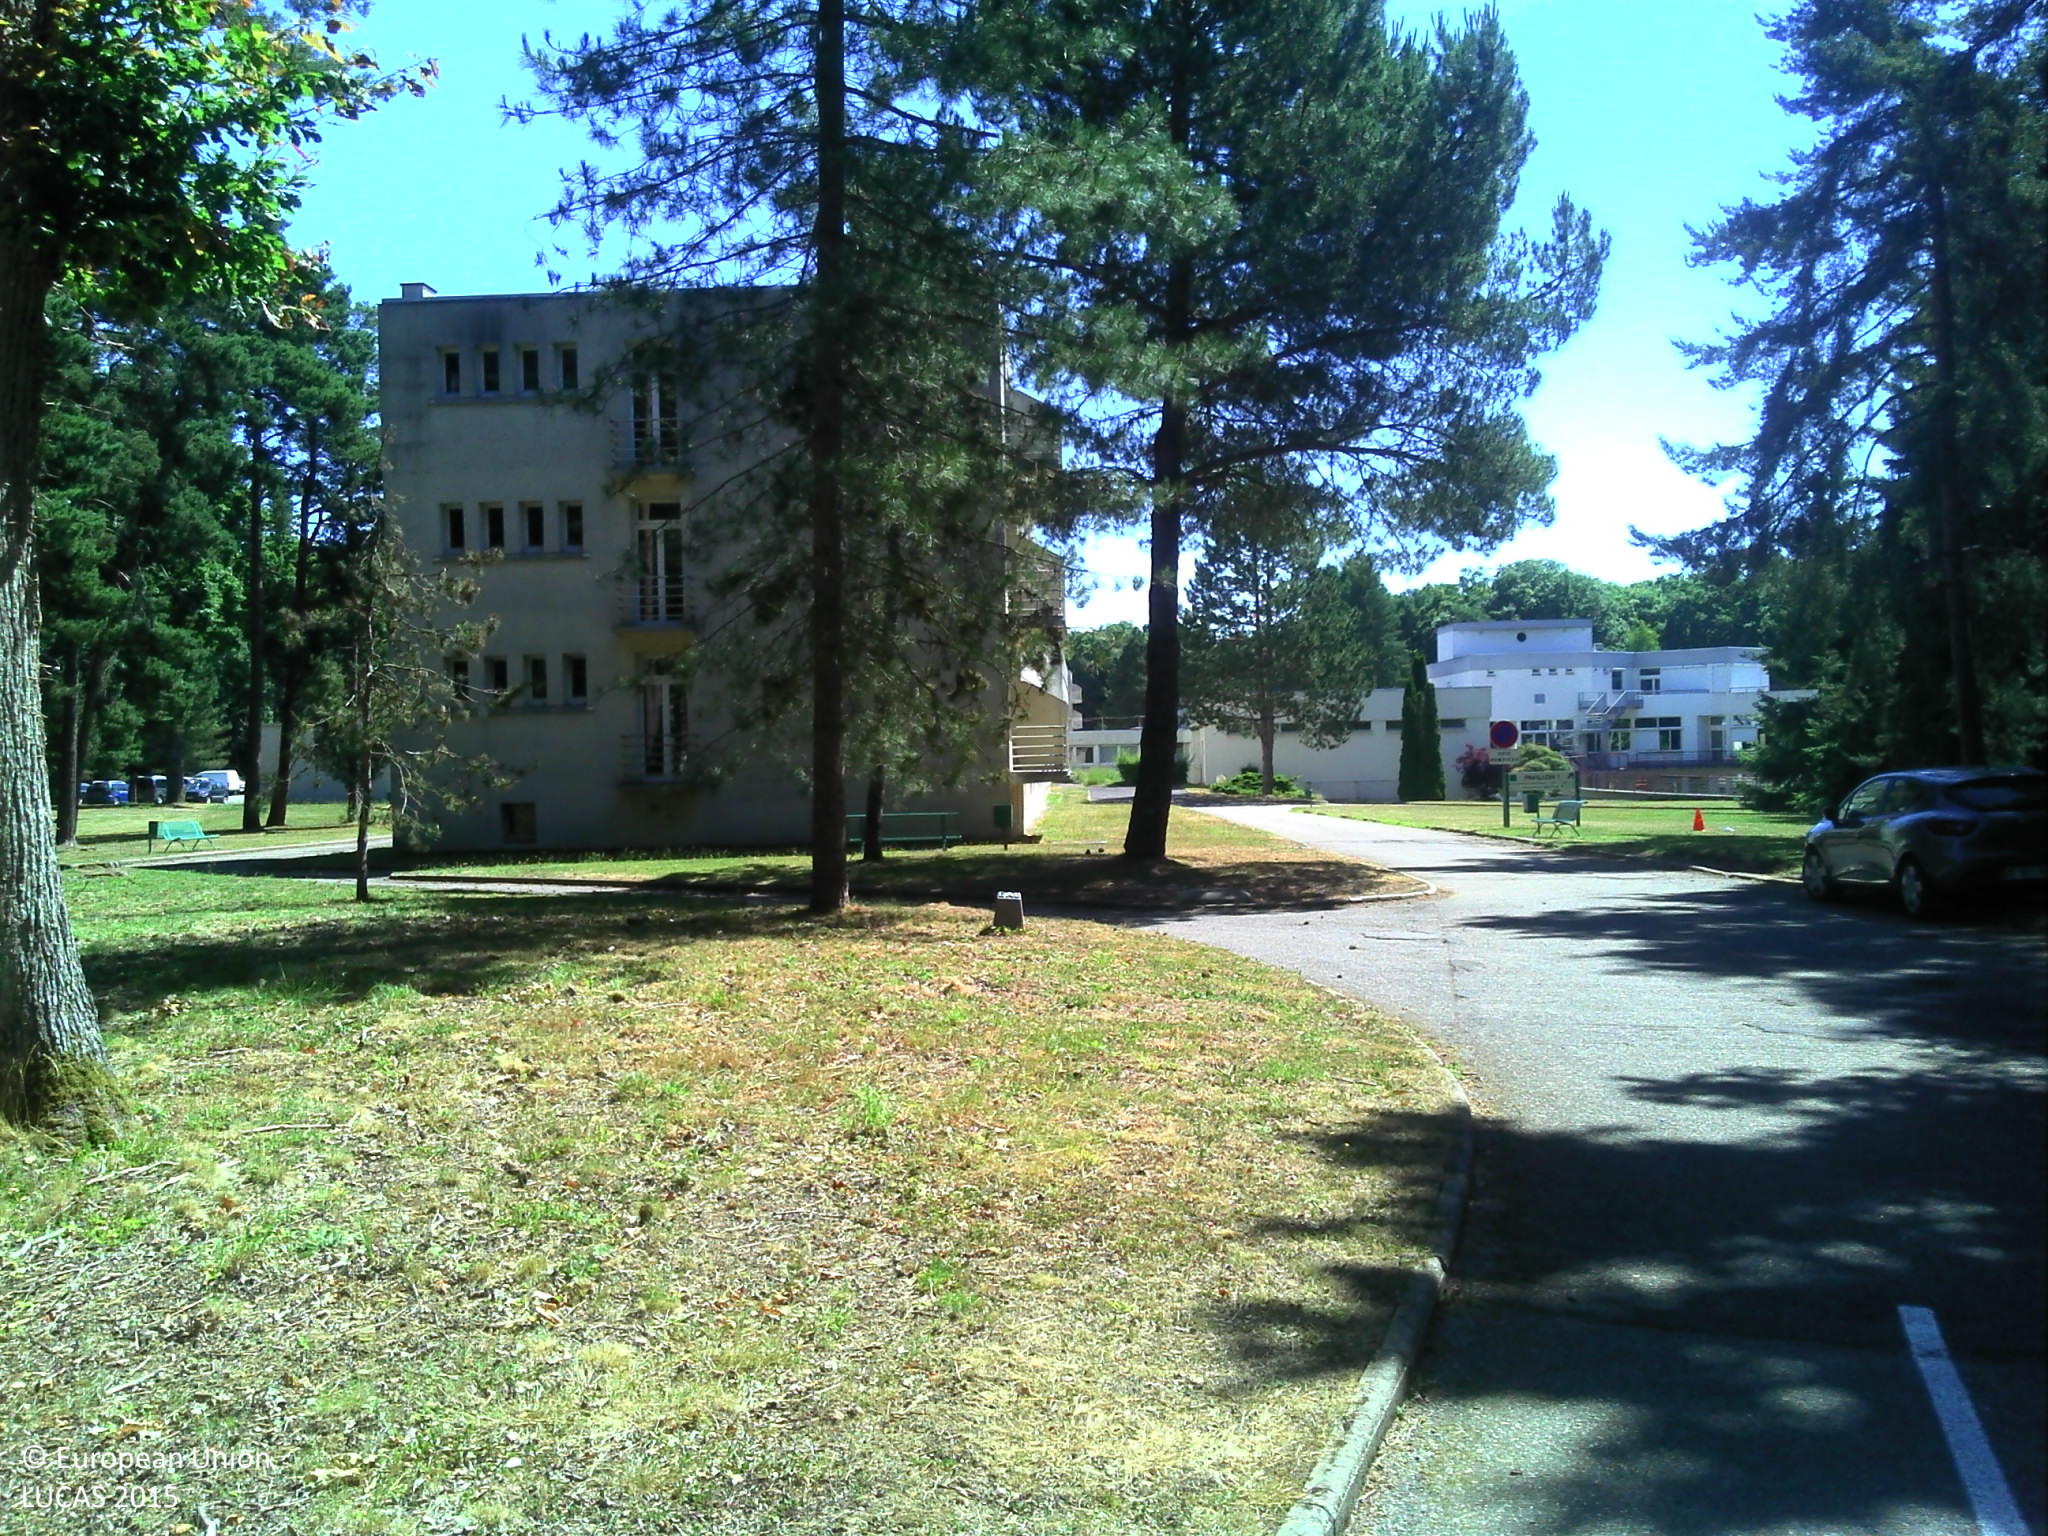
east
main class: Woodland
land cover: Broadleaved woodland
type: mesophytic deciduous forest
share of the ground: > 75 %
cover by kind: broadleaved forest trees 80 %, herbaceous plants 20 %
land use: Community services
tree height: > 5 m
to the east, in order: Paved roads, cycling and walking lanes; Broadleaved woodland; Grassland without tree/shrub cover; Paved roads, cycling and walking lanes; Grassland without tree/shrub cover; Artificial constructions in urban areas; Pine dominated mixed woodland
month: June
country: FR
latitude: 49.0017
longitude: 1.0803
